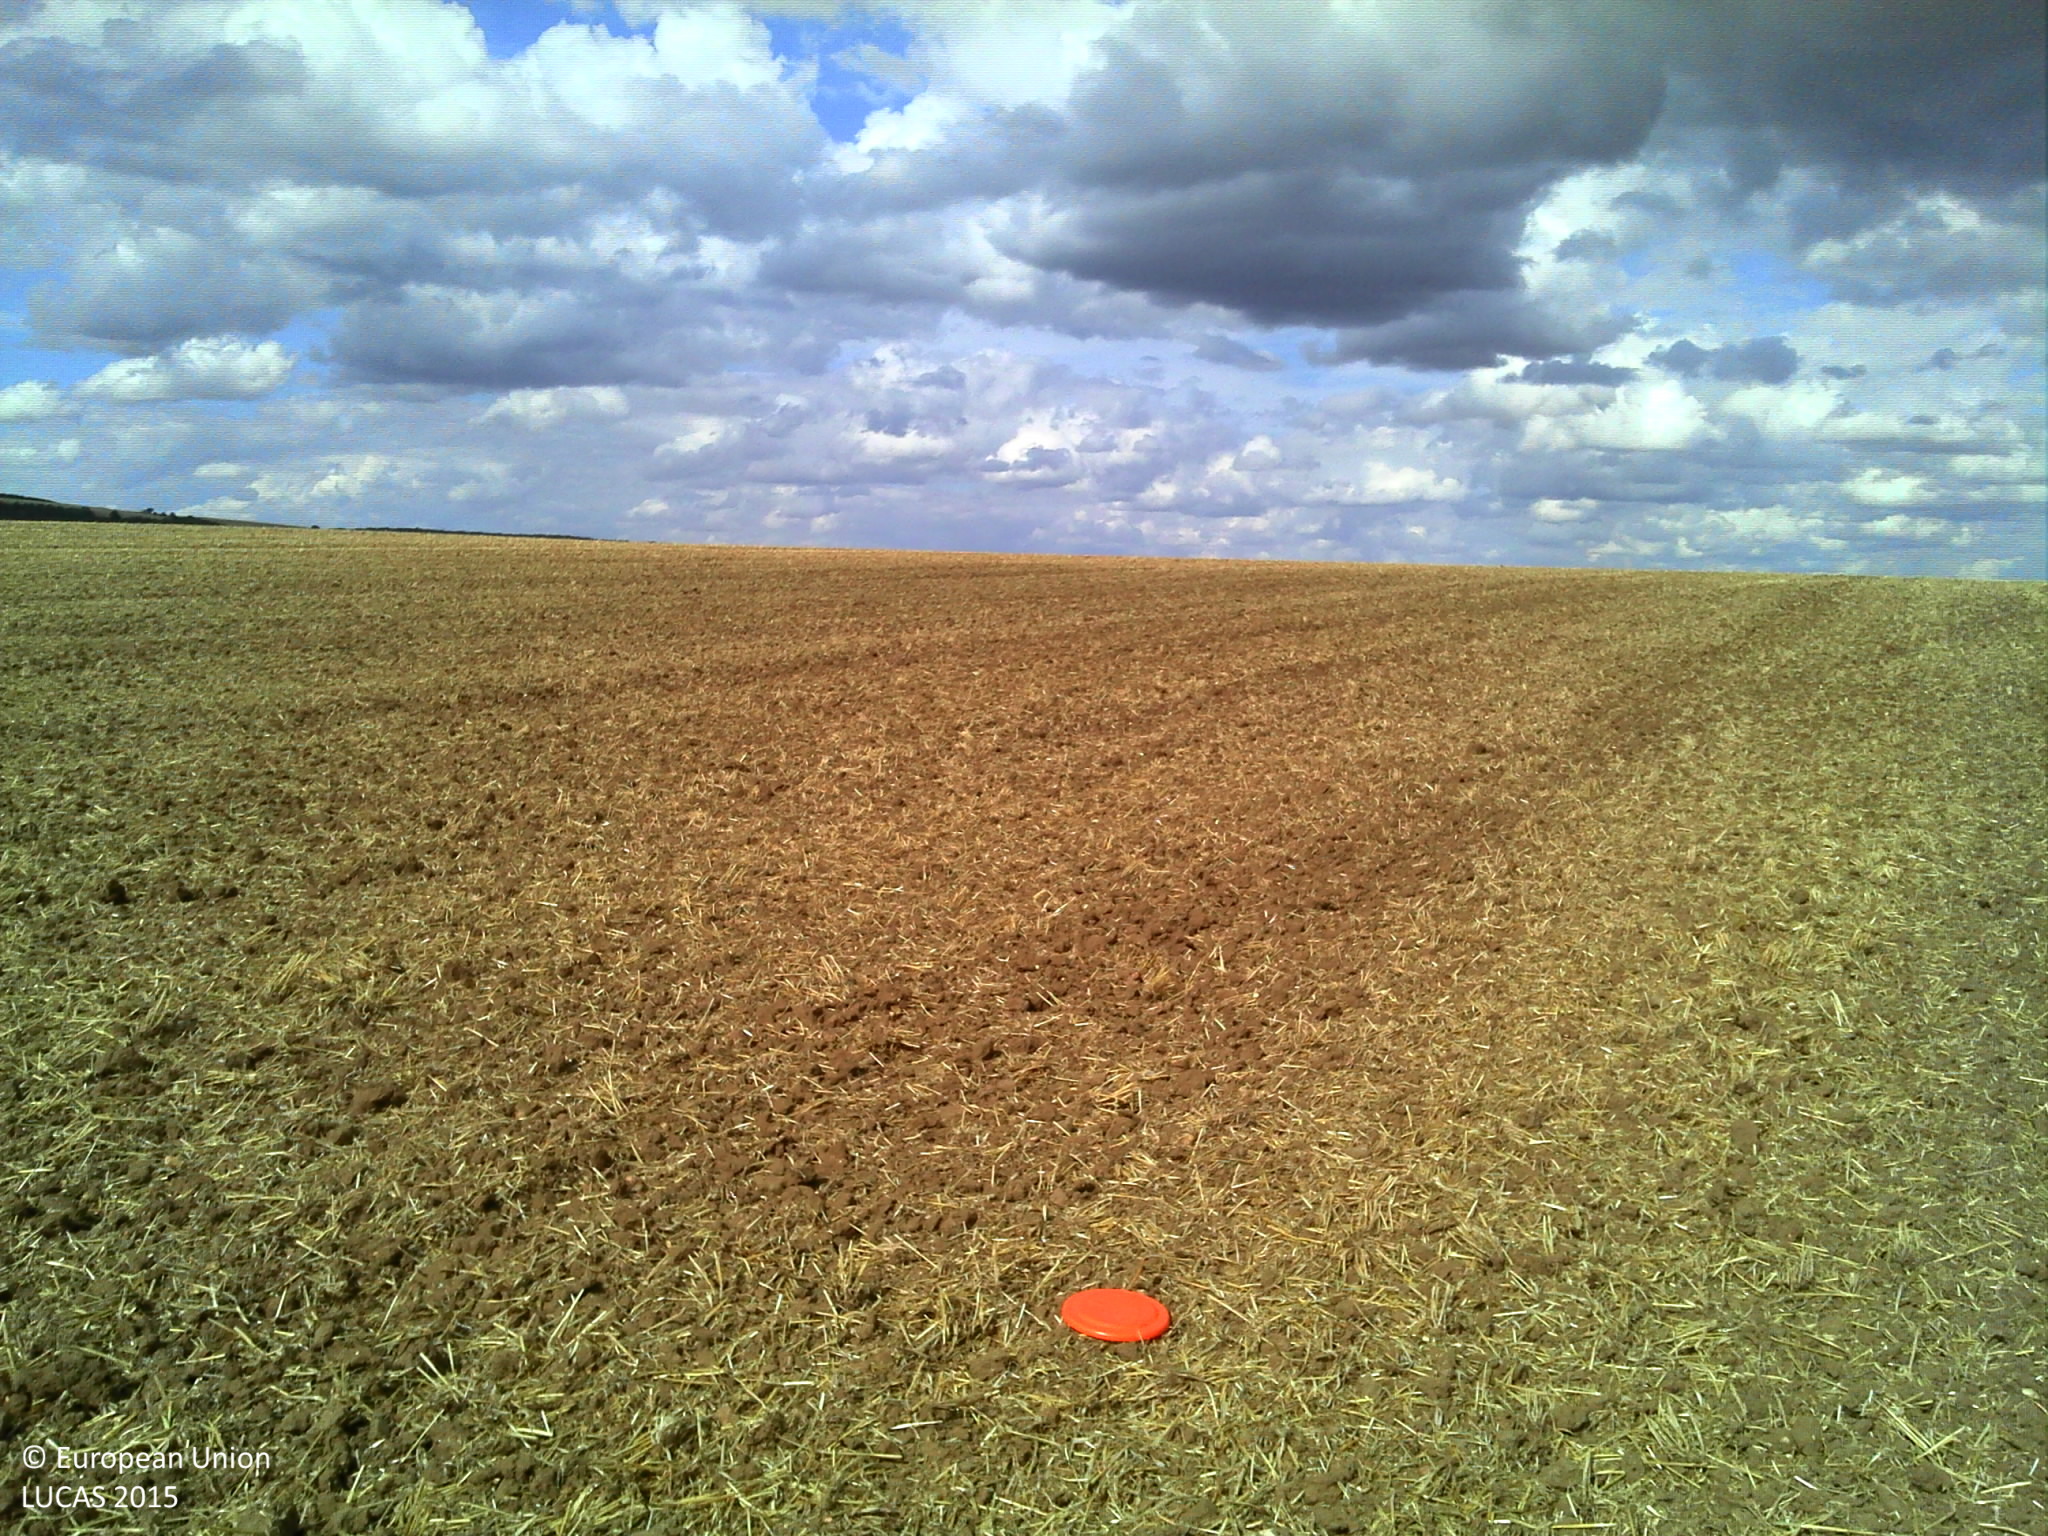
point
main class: Cropland
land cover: Common wheat
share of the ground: > 75 %
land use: Agriculture (excluding fallow land and kitchen gardens)
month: July
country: FR
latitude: 47.9742
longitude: 3.4442
